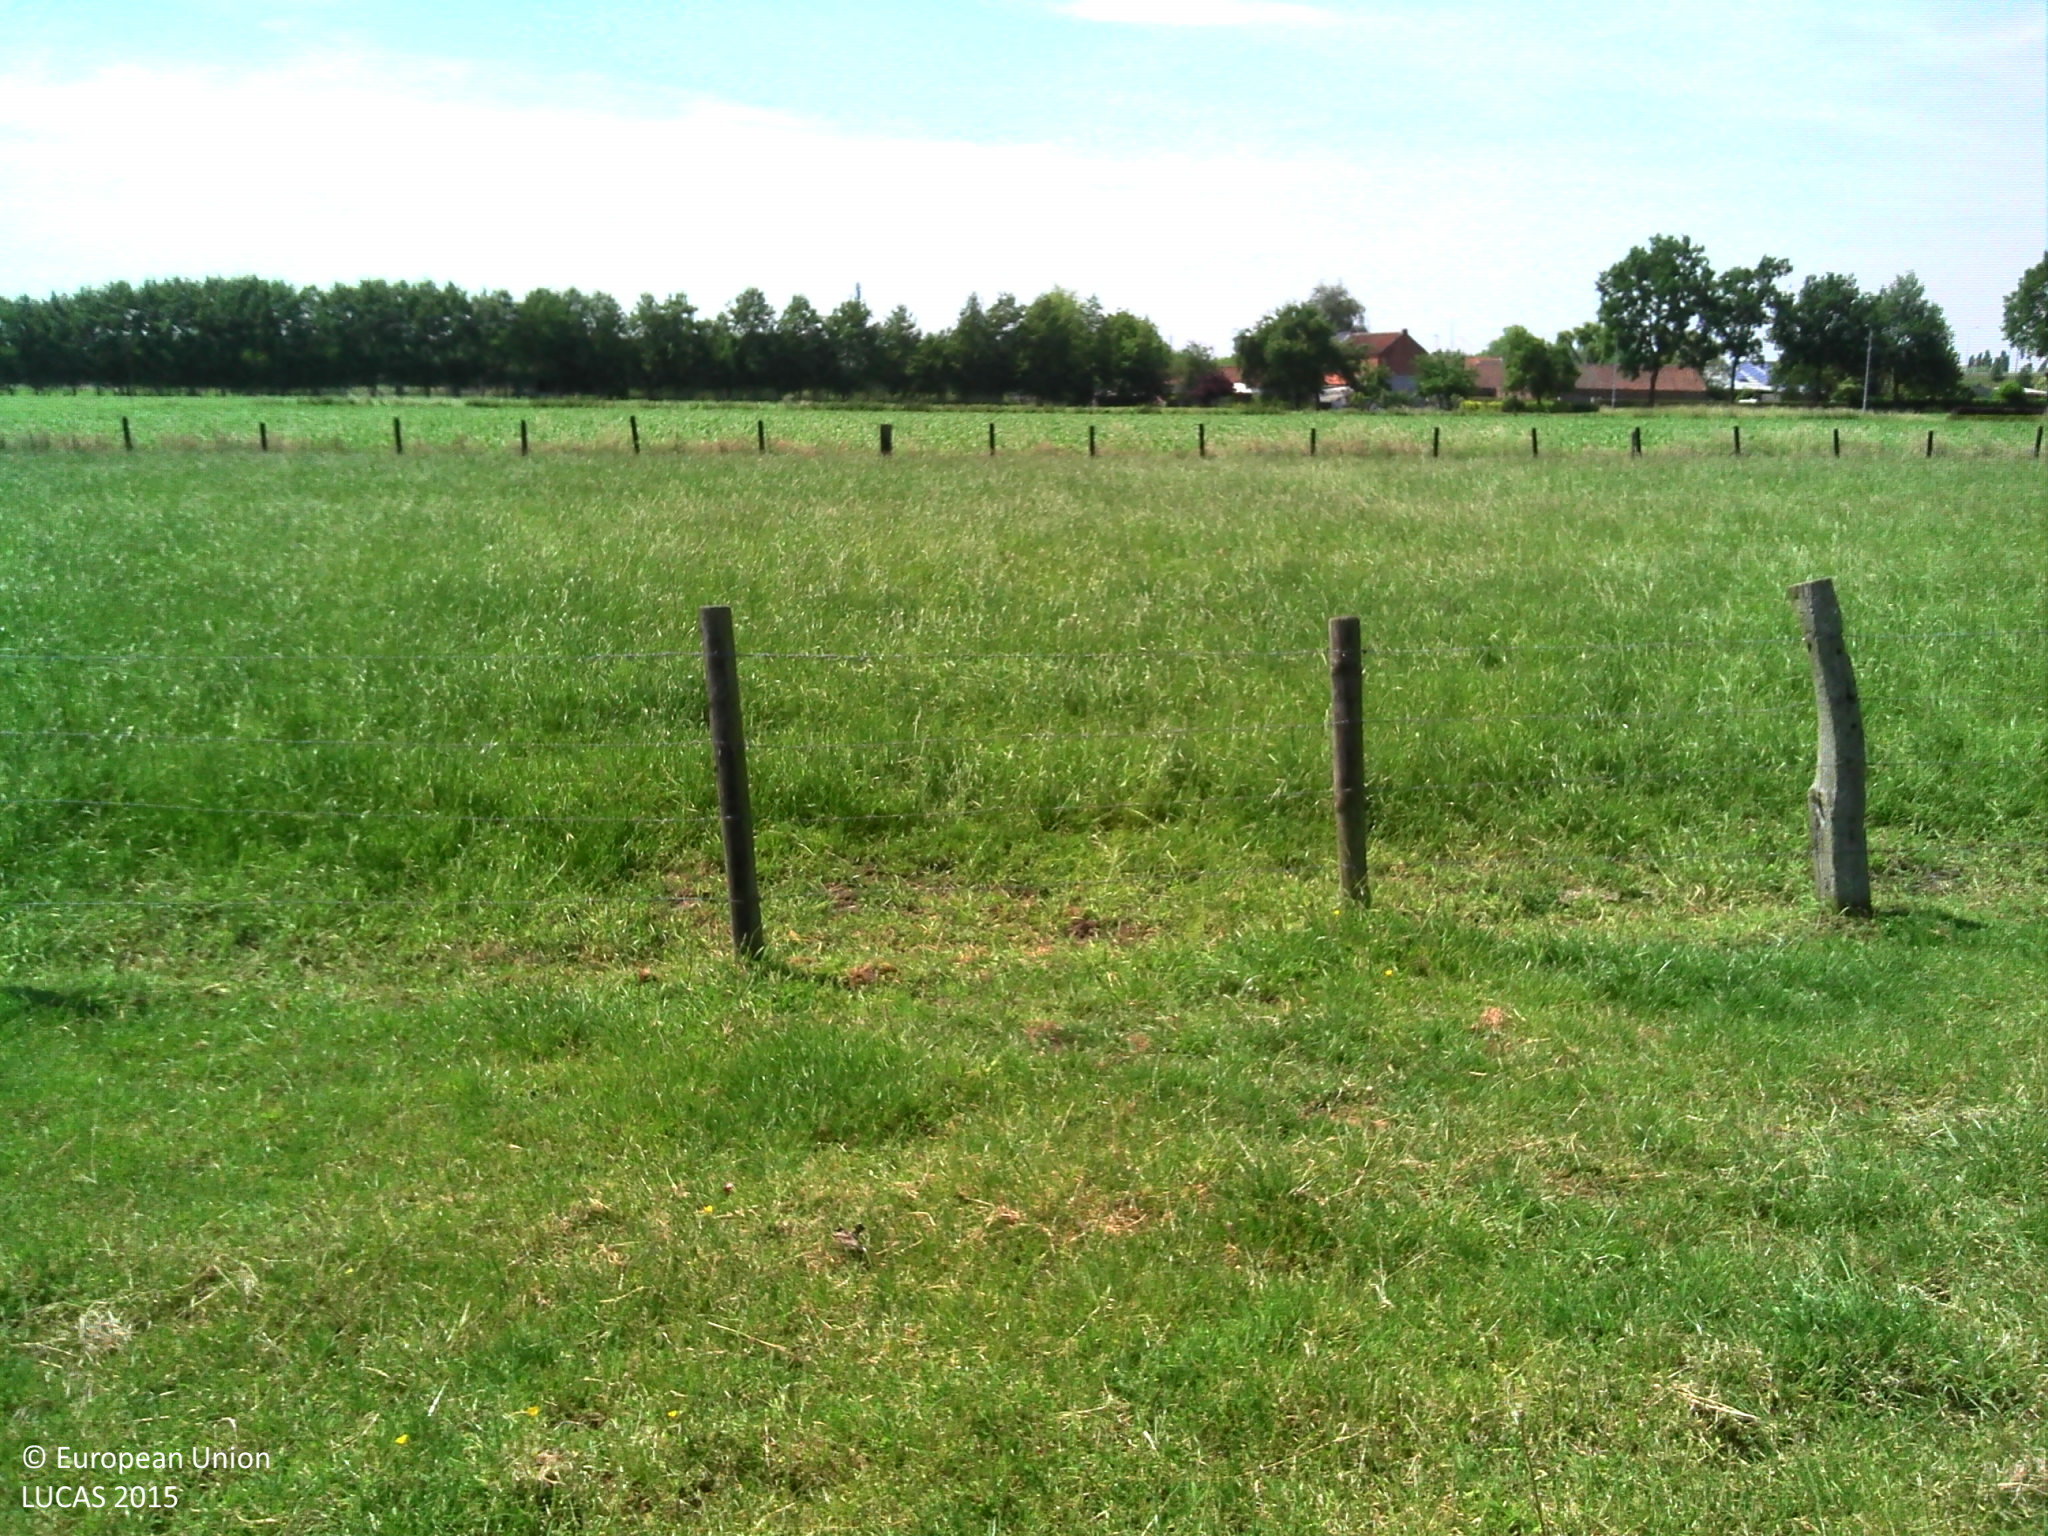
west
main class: Grassland
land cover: Grassland without tree/shrub cover
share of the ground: > 75 %
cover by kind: herbaceous plants 100 %
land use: Agriculture (excluding fallow land and kitchen gardens)
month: June
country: BE
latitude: 51.0921
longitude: 4.0403
